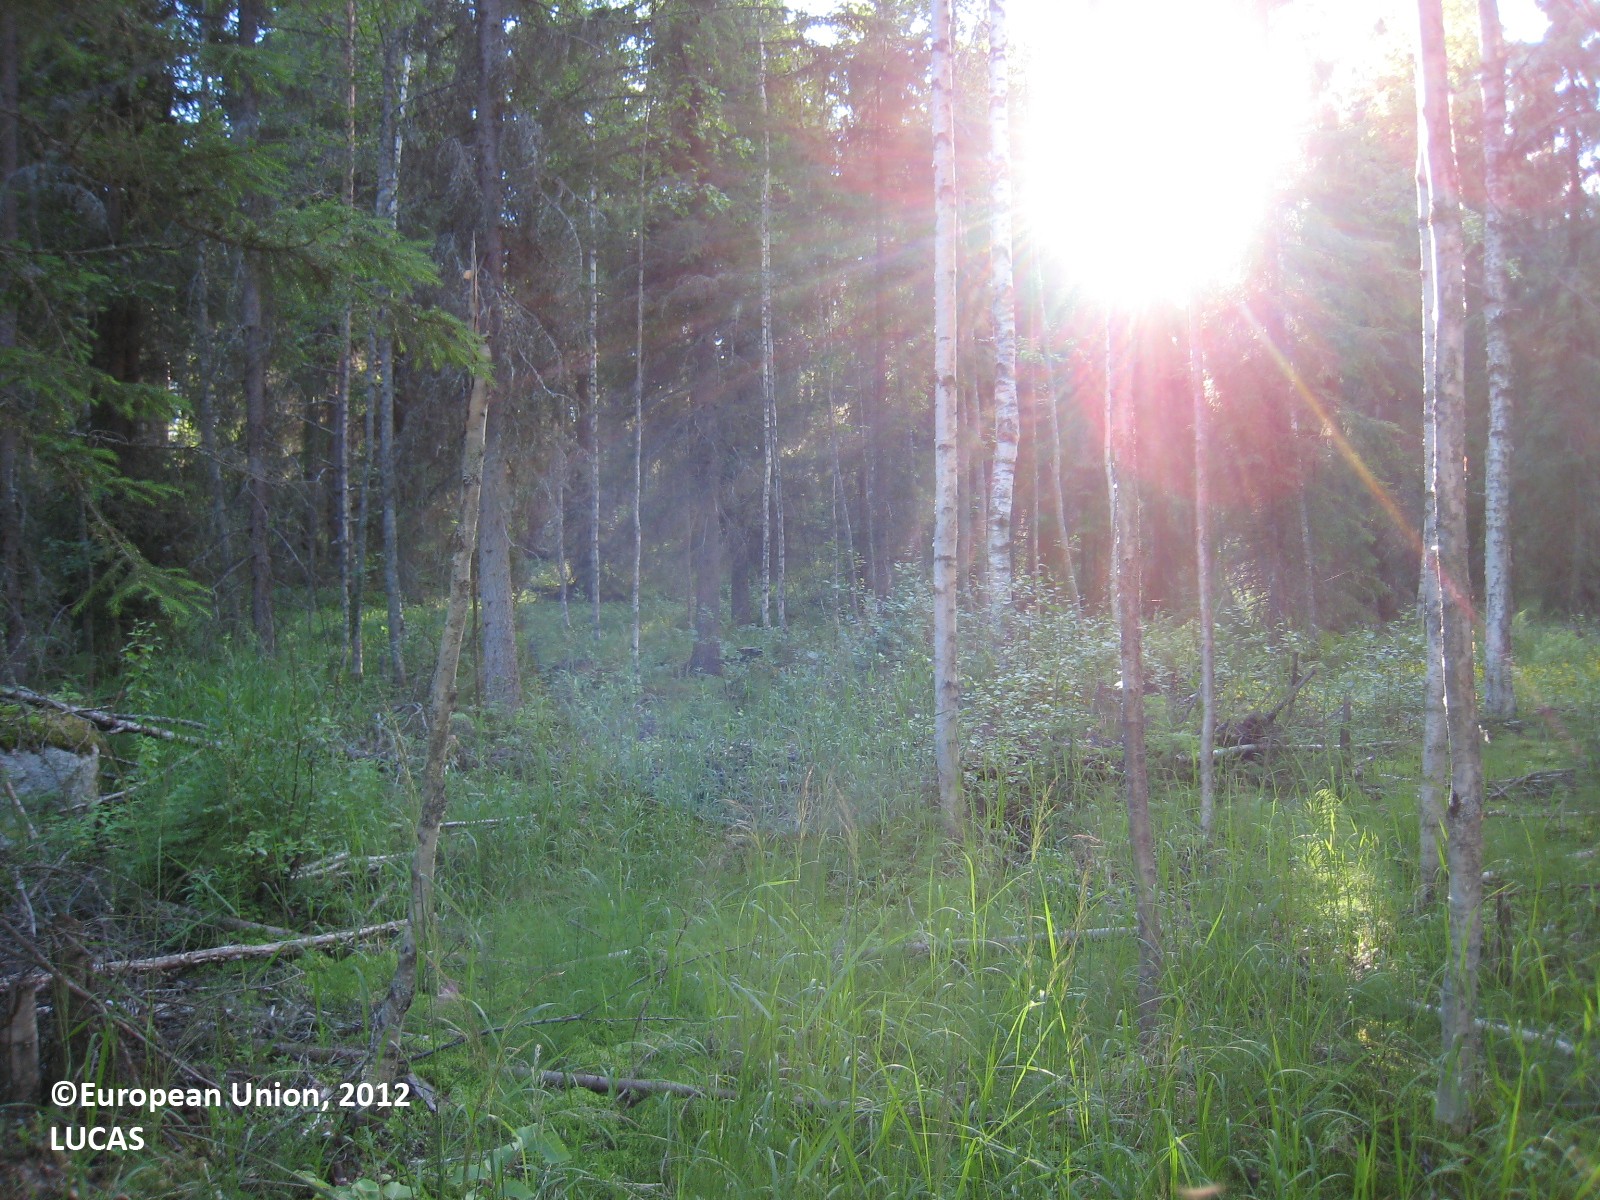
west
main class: Woodland
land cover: Spruce dominated mixed woodland
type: boreal forest
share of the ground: 50 - 75 %
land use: Forestry
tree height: > 5 m
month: July
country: FI
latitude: 63.1486
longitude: 25.6876
